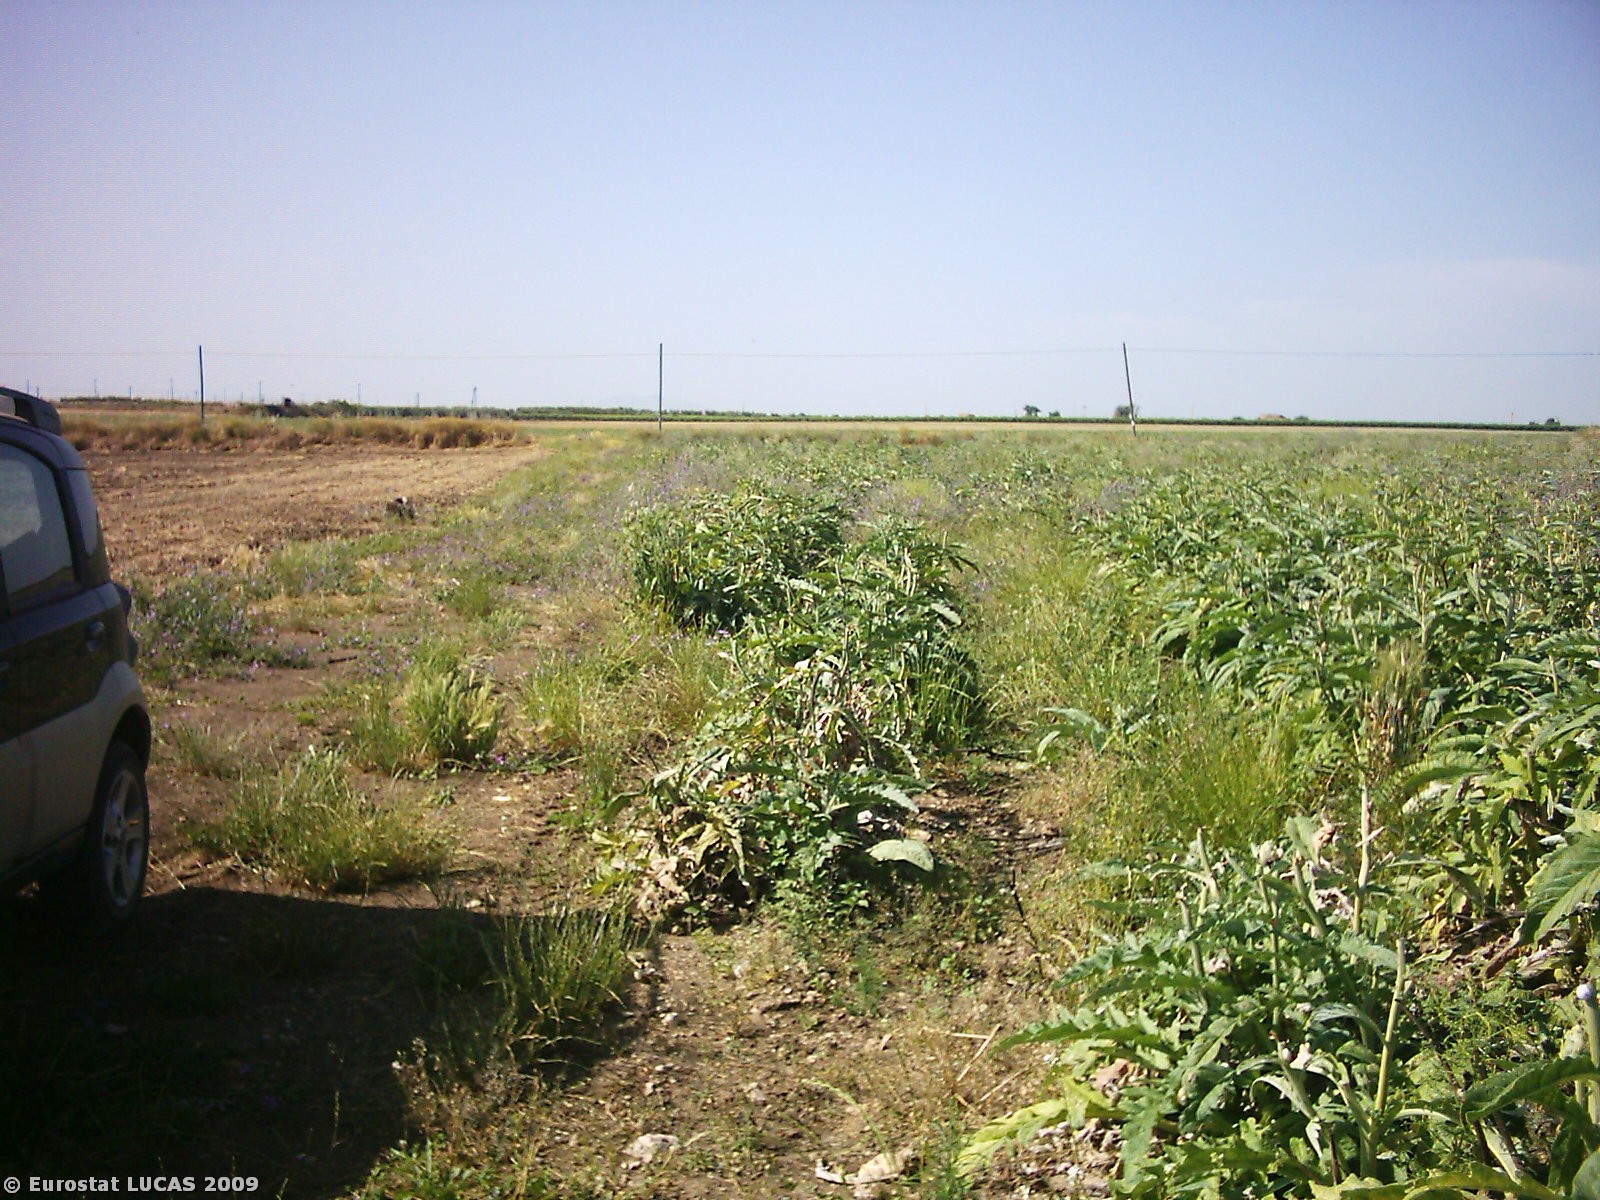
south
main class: Cropland
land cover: Other fresh vegetables
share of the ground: 50 - 75 %
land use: Agriculture (excluding fallow land and kitchen gardens)
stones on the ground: > 50 %
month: May
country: IT
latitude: 41.2995
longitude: 15.6777
